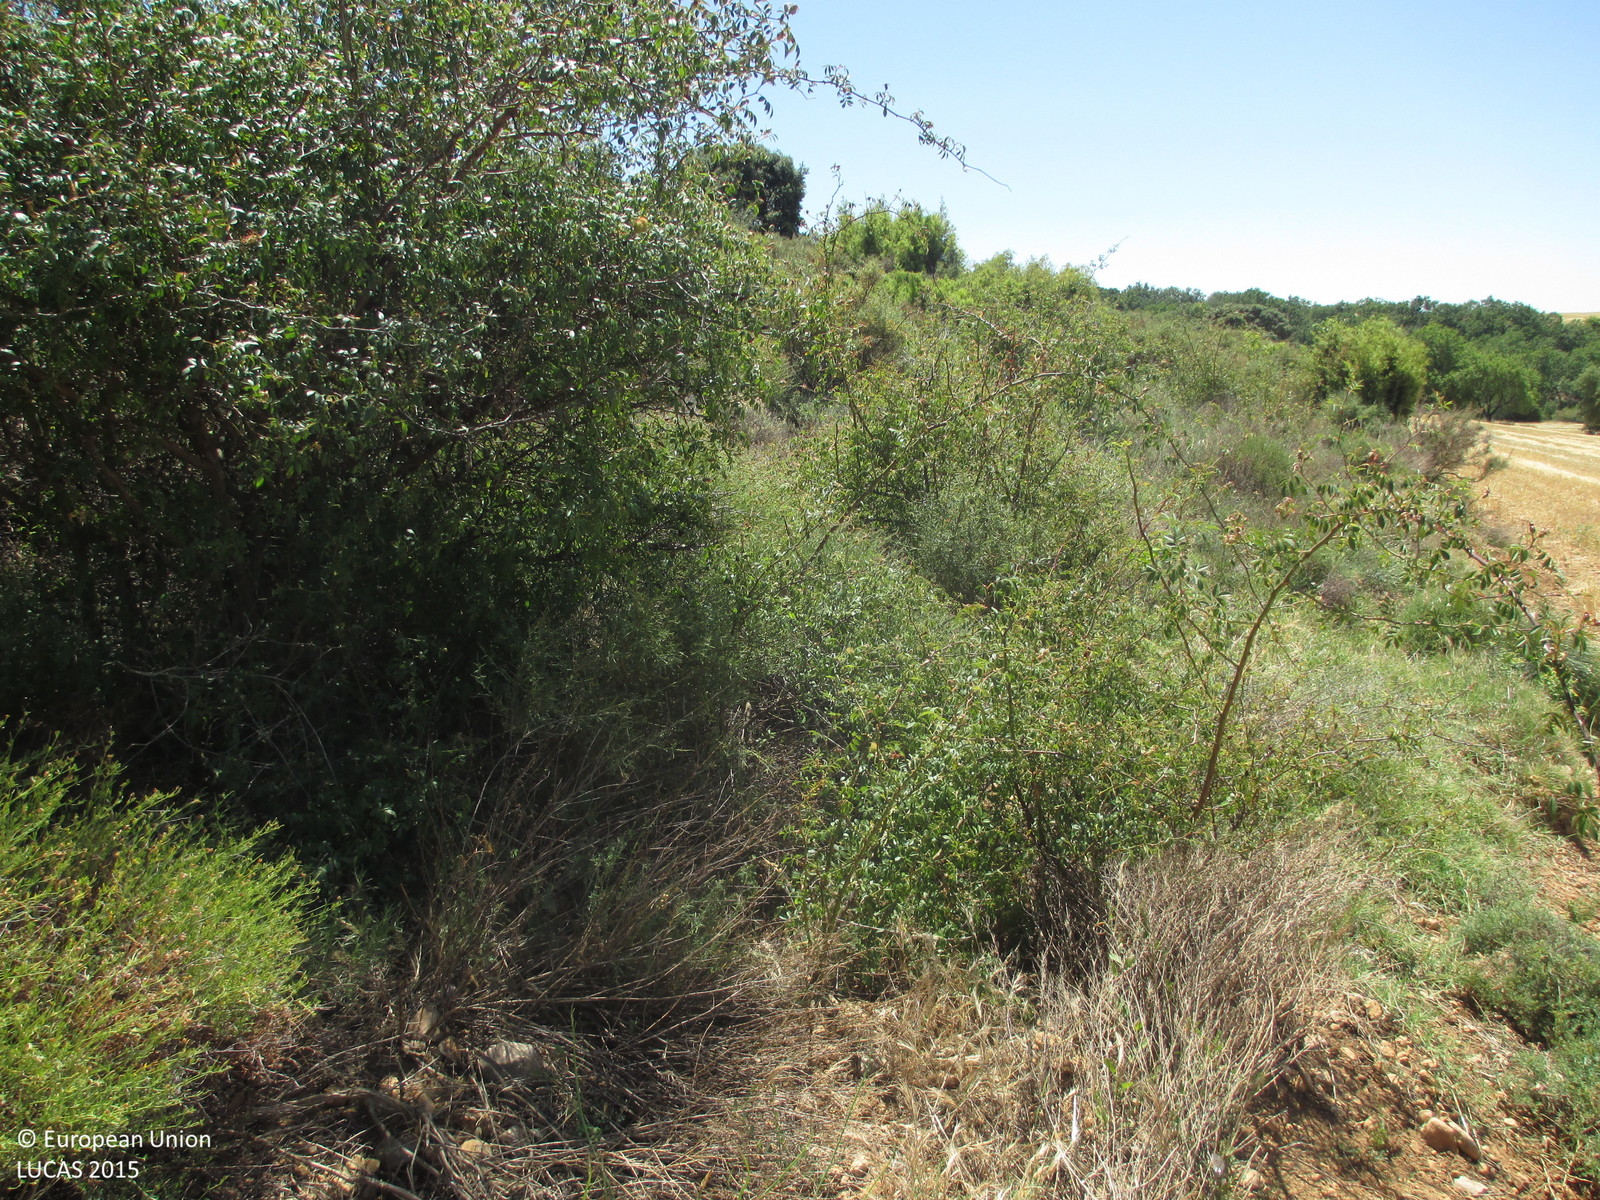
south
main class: Shrubland
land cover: Shrubland with sparse tree cover
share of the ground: > 75 %
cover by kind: shrubs 90 %, broadleaved forest trees 5 %, herbaceous plants 5 %
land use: Semi-natural and natural areas not in use
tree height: < 5 m
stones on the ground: < 10 %
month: June
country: ES
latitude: 42.2307
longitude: -0.3585
